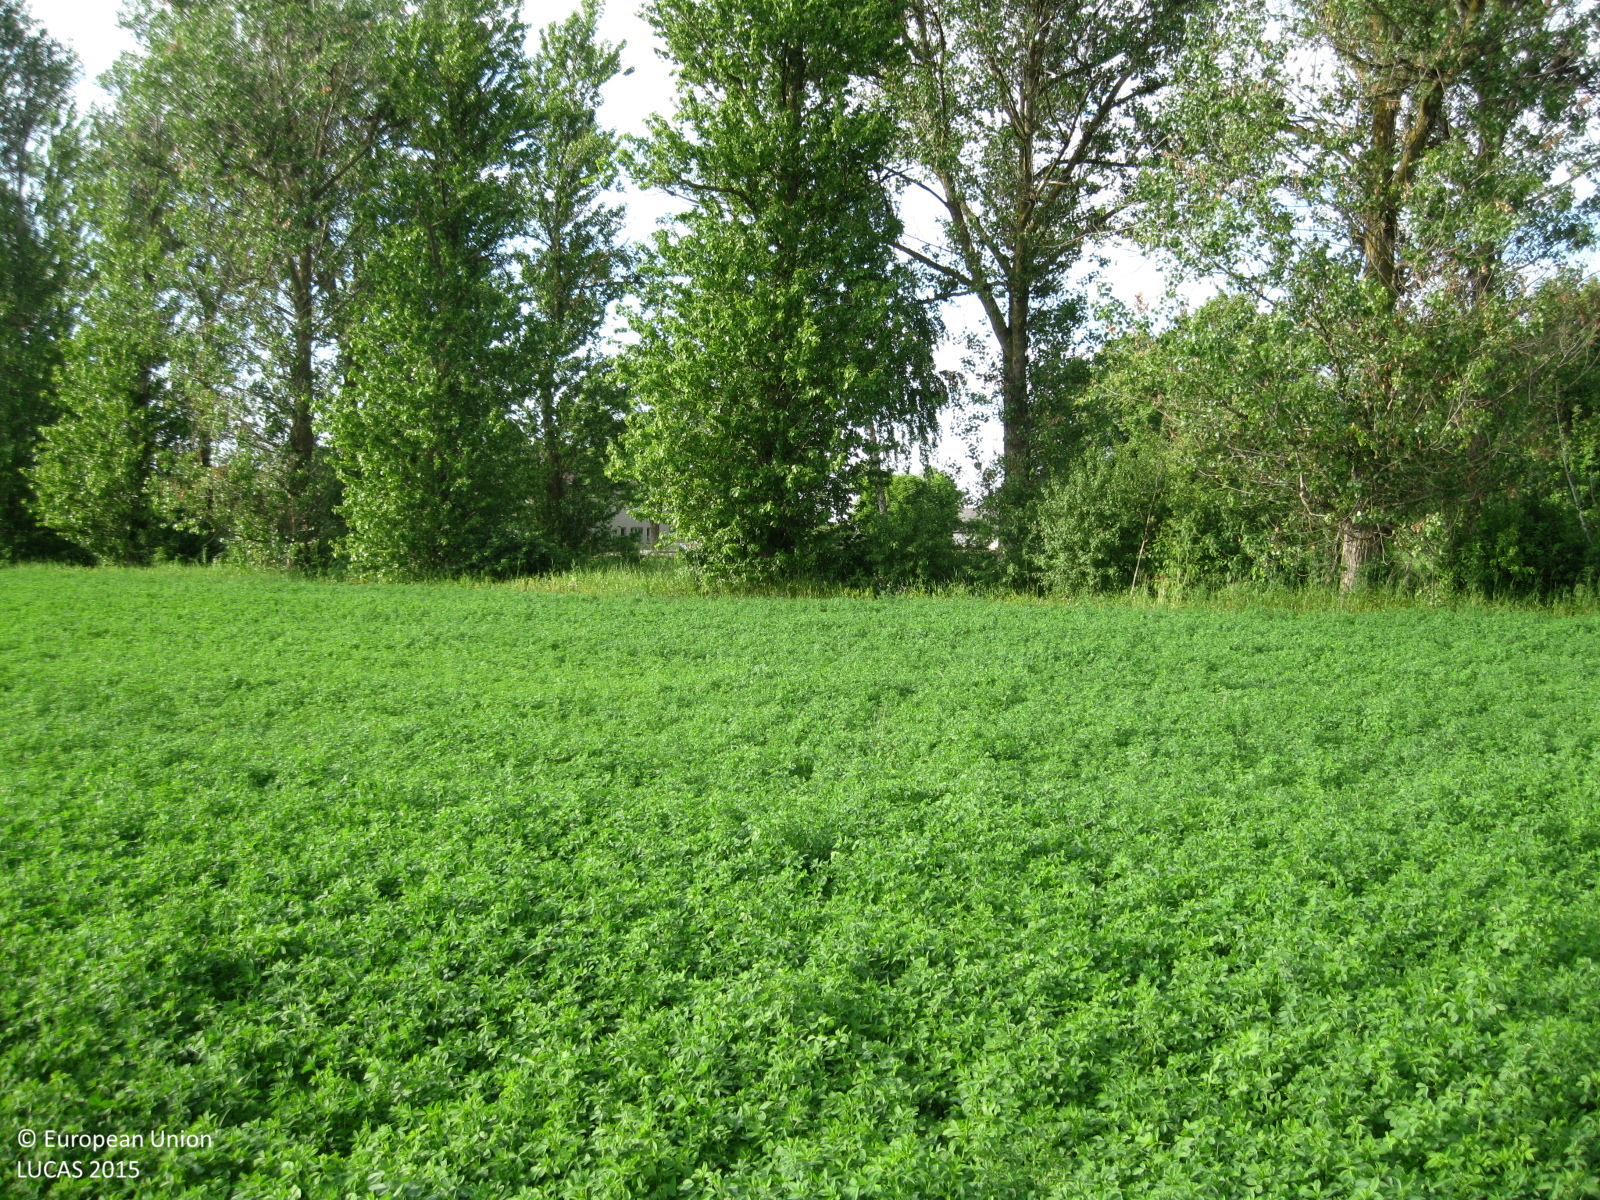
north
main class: Cropland
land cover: Clovers
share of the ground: > 75 %
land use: Agriculture (excluding fallow land and kitchen gardens)
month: June
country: LT
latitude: 55.1892
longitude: 23.8945
